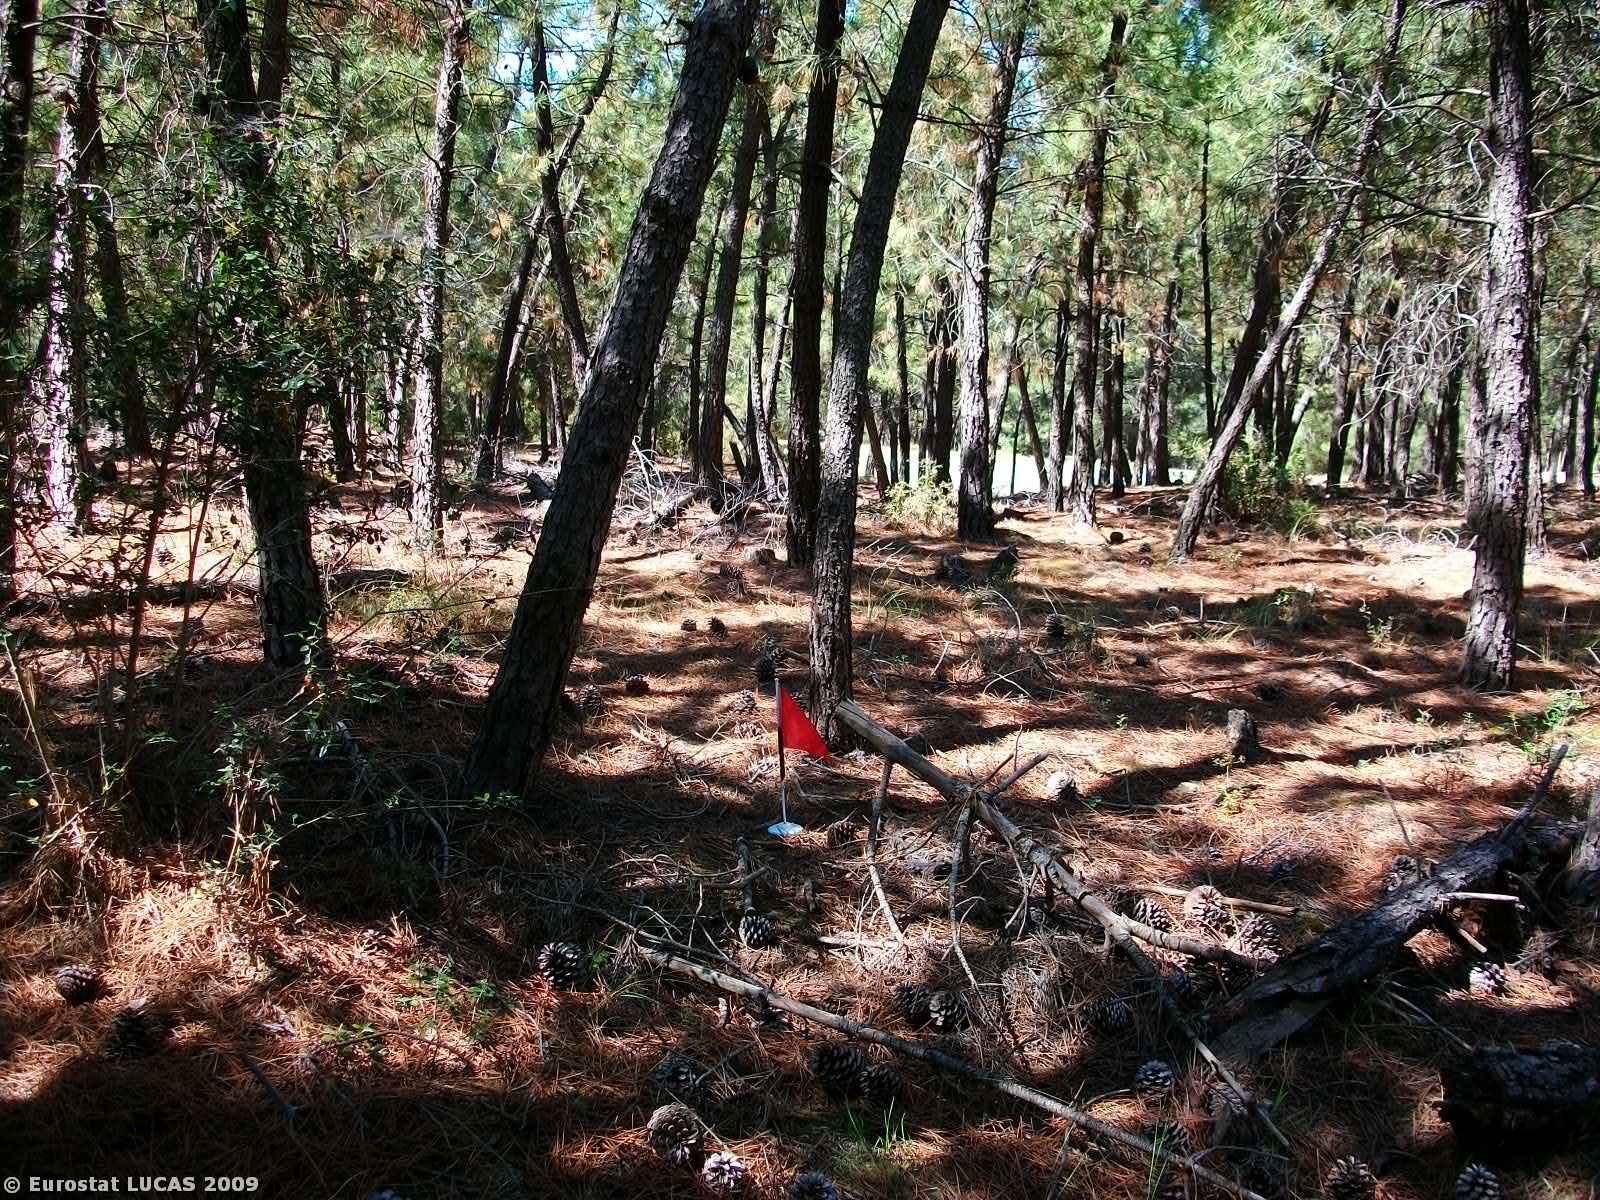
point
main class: Woodland
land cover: Coniferous woodland
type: coniferous forest of the mediterranean region
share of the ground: > 75 %
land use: Forestry
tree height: > 5 m
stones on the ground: < 10 %
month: June
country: GR
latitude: 40.9769
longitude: 25.4880
